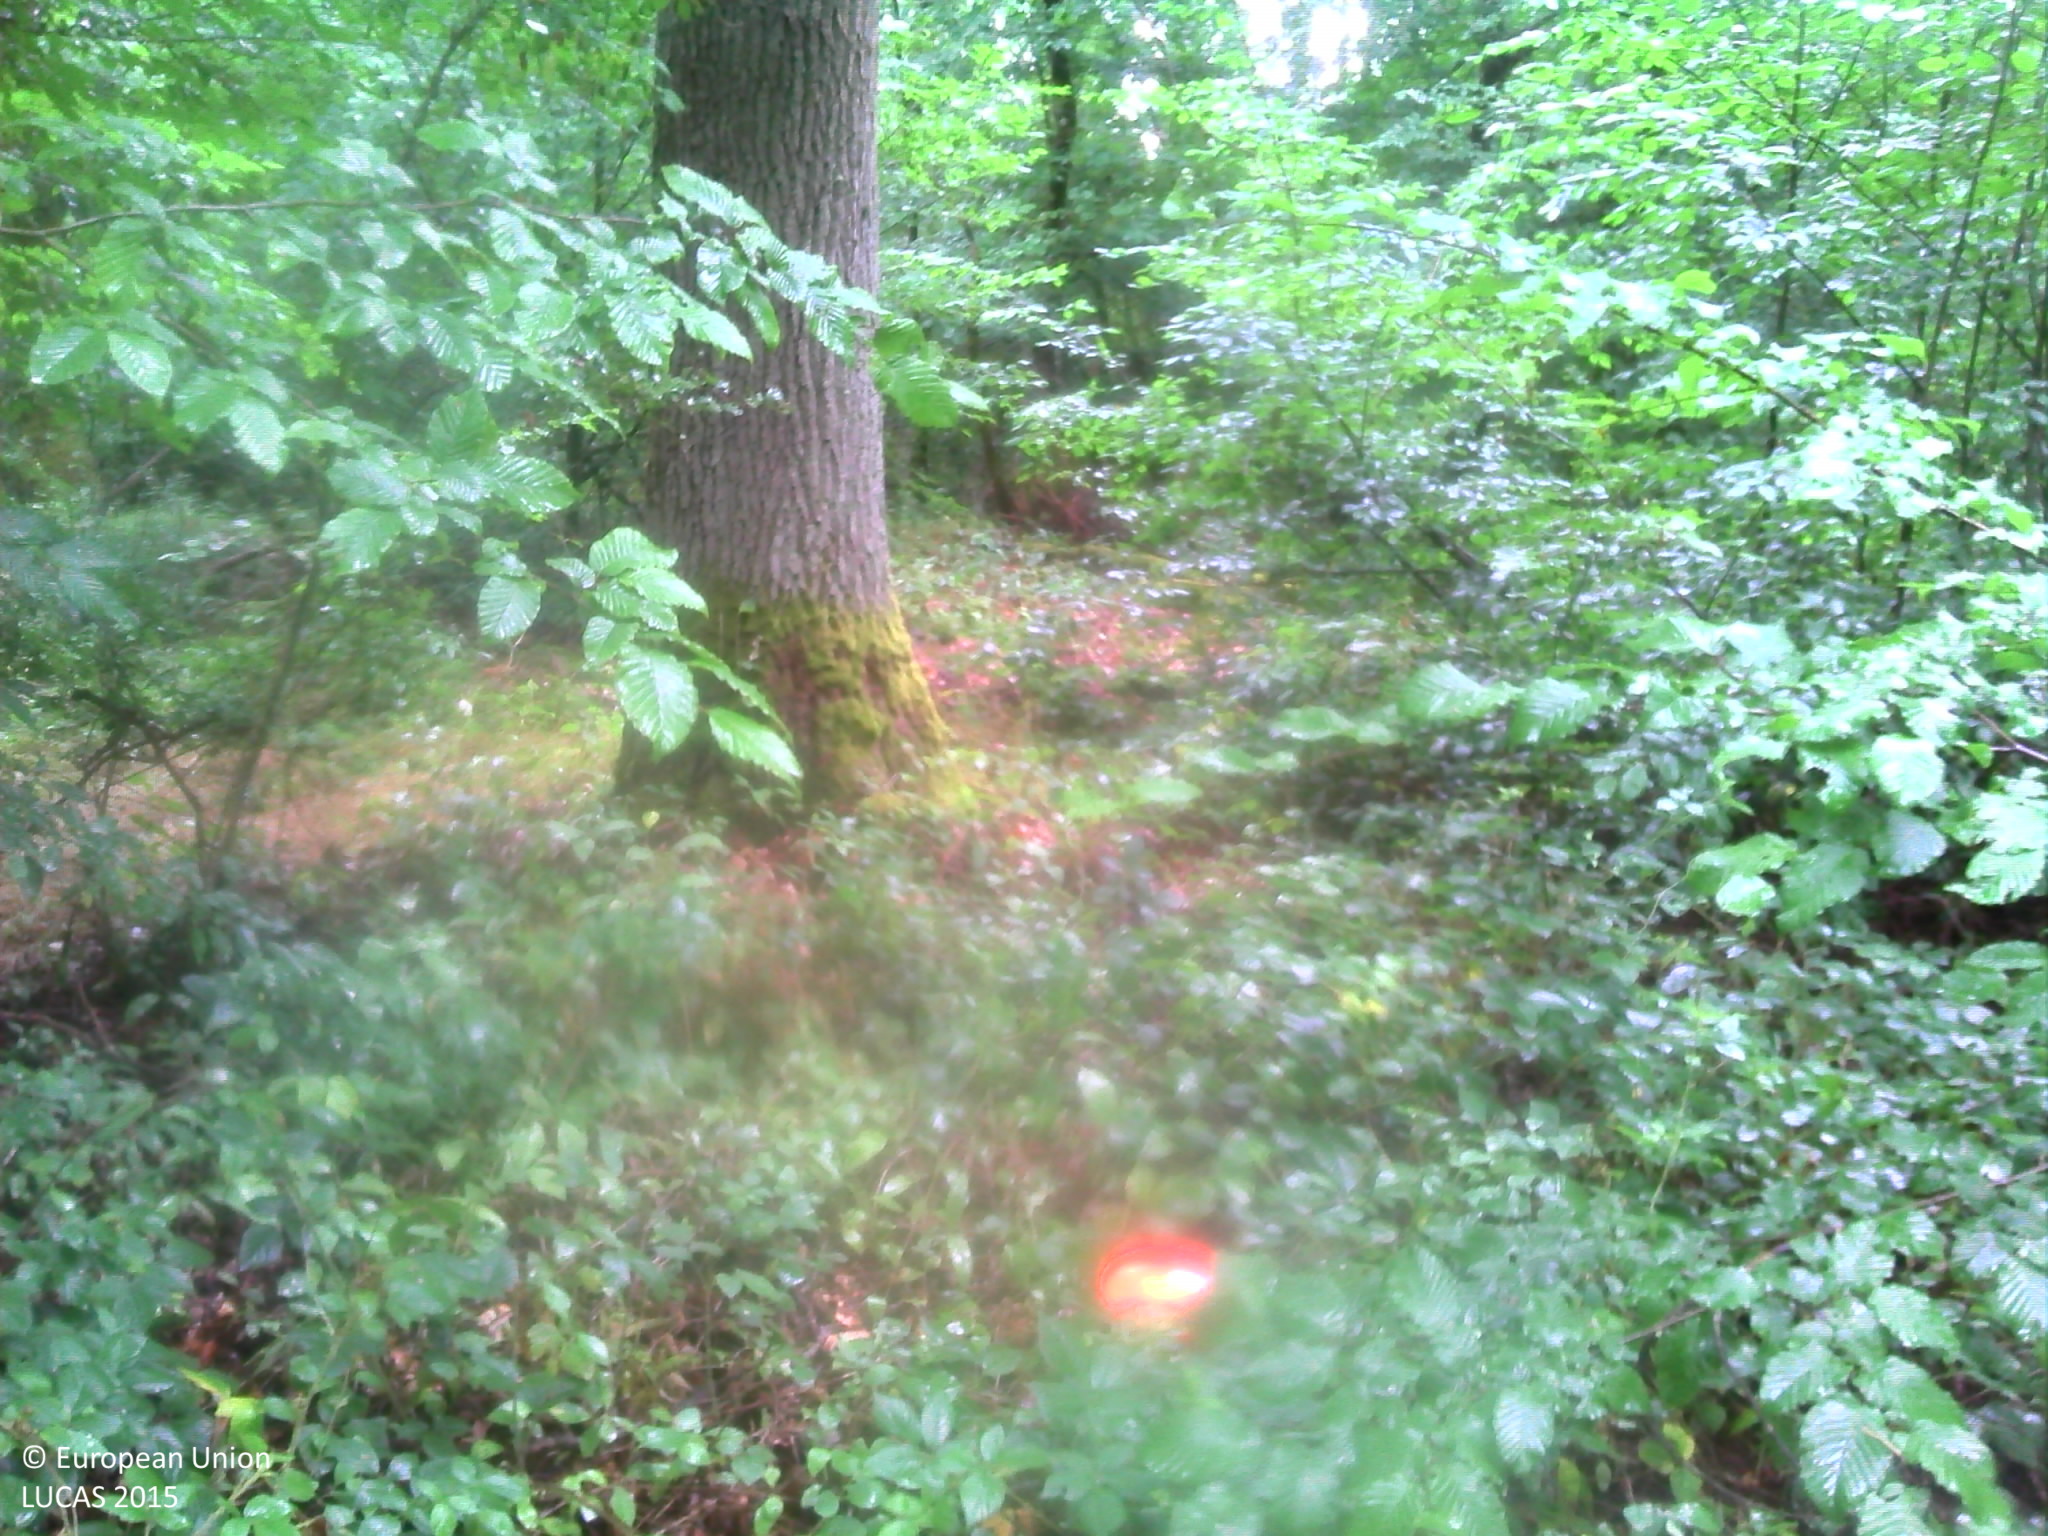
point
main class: Woodland
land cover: Pine dominated mixed woodland
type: hemiboreal forest and nemoral coniferous forest and mixed broadleaved-coniferous forest
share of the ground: > 75 %
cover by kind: coniferous forest trees 60 %, broadleaved forest trees 30 %, shrubs 5 %, herbaceous plants 5 %
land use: Forestry
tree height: > 5 m
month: July
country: BE
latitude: 50.1521
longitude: 4.7203
